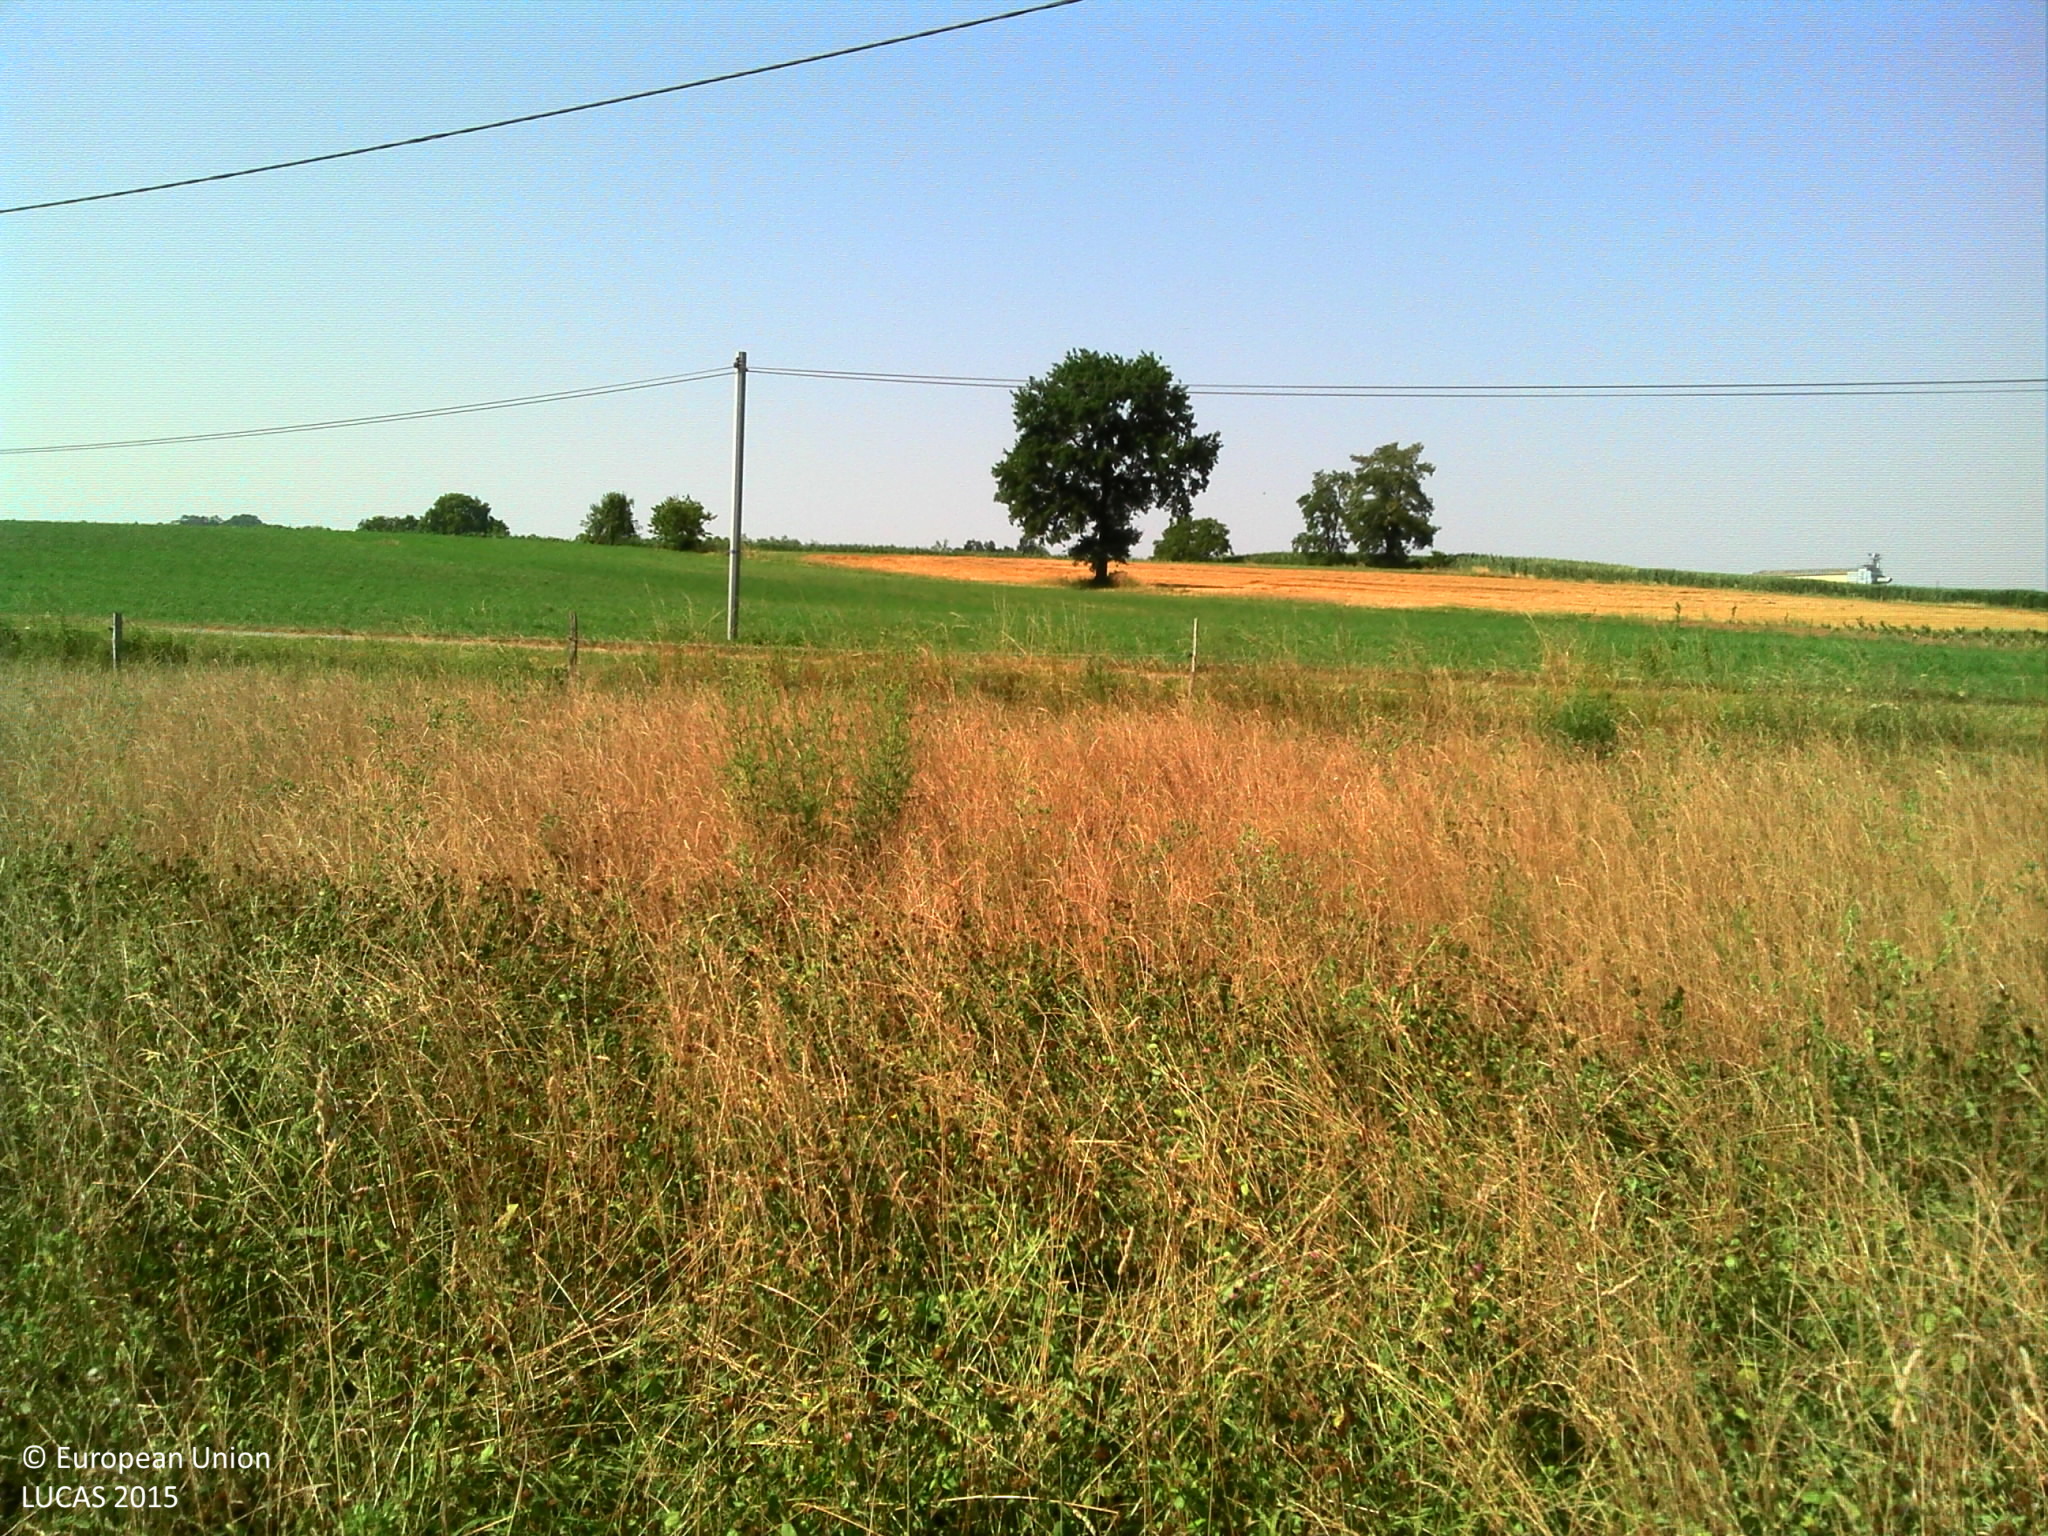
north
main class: Grassland
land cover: Grassland without tree/shrub cover
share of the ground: > 75 %
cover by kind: herbaceous plants 100 %
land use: Agriculture (excluding fallow land and kitchen gardens)
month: July
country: FR
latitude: 44.4386
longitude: 0.8863
